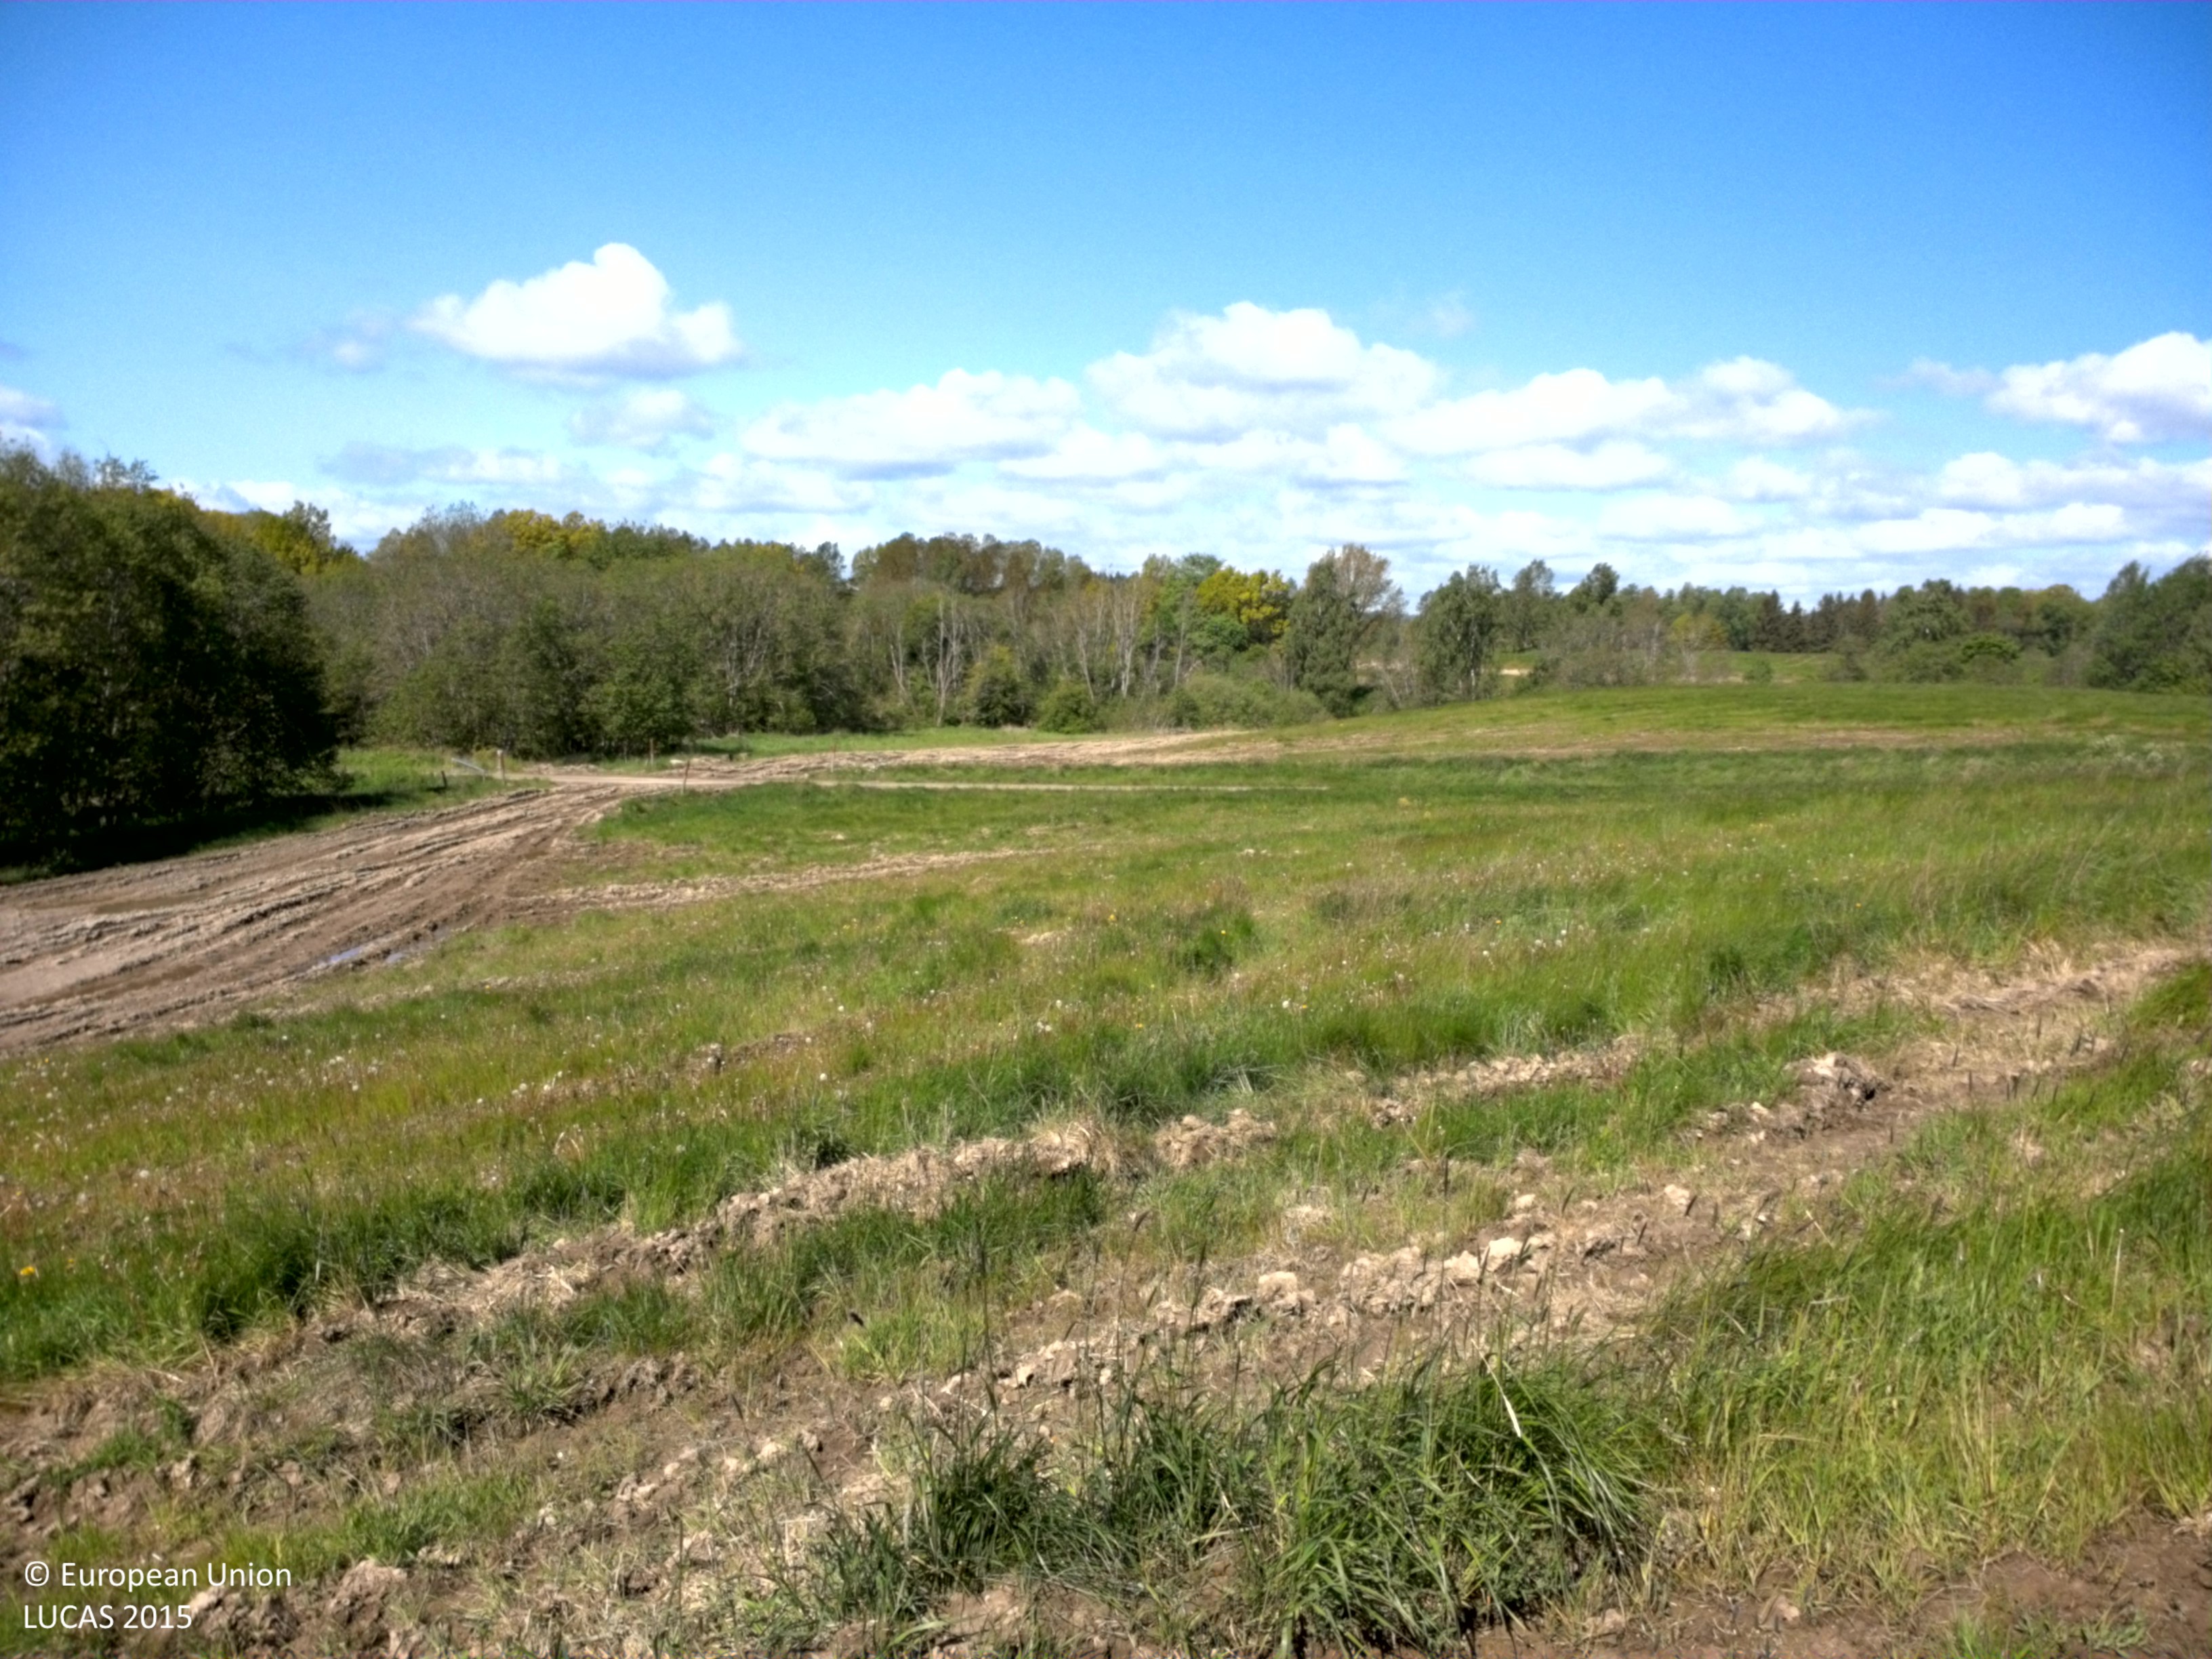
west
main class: Grassland
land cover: Grassland without tree/shrub cover
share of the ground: > 75 %
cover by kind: herbaceous plants 100 %
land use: Community services
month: June
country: SE
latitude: 58.3429
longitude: 13.9059
